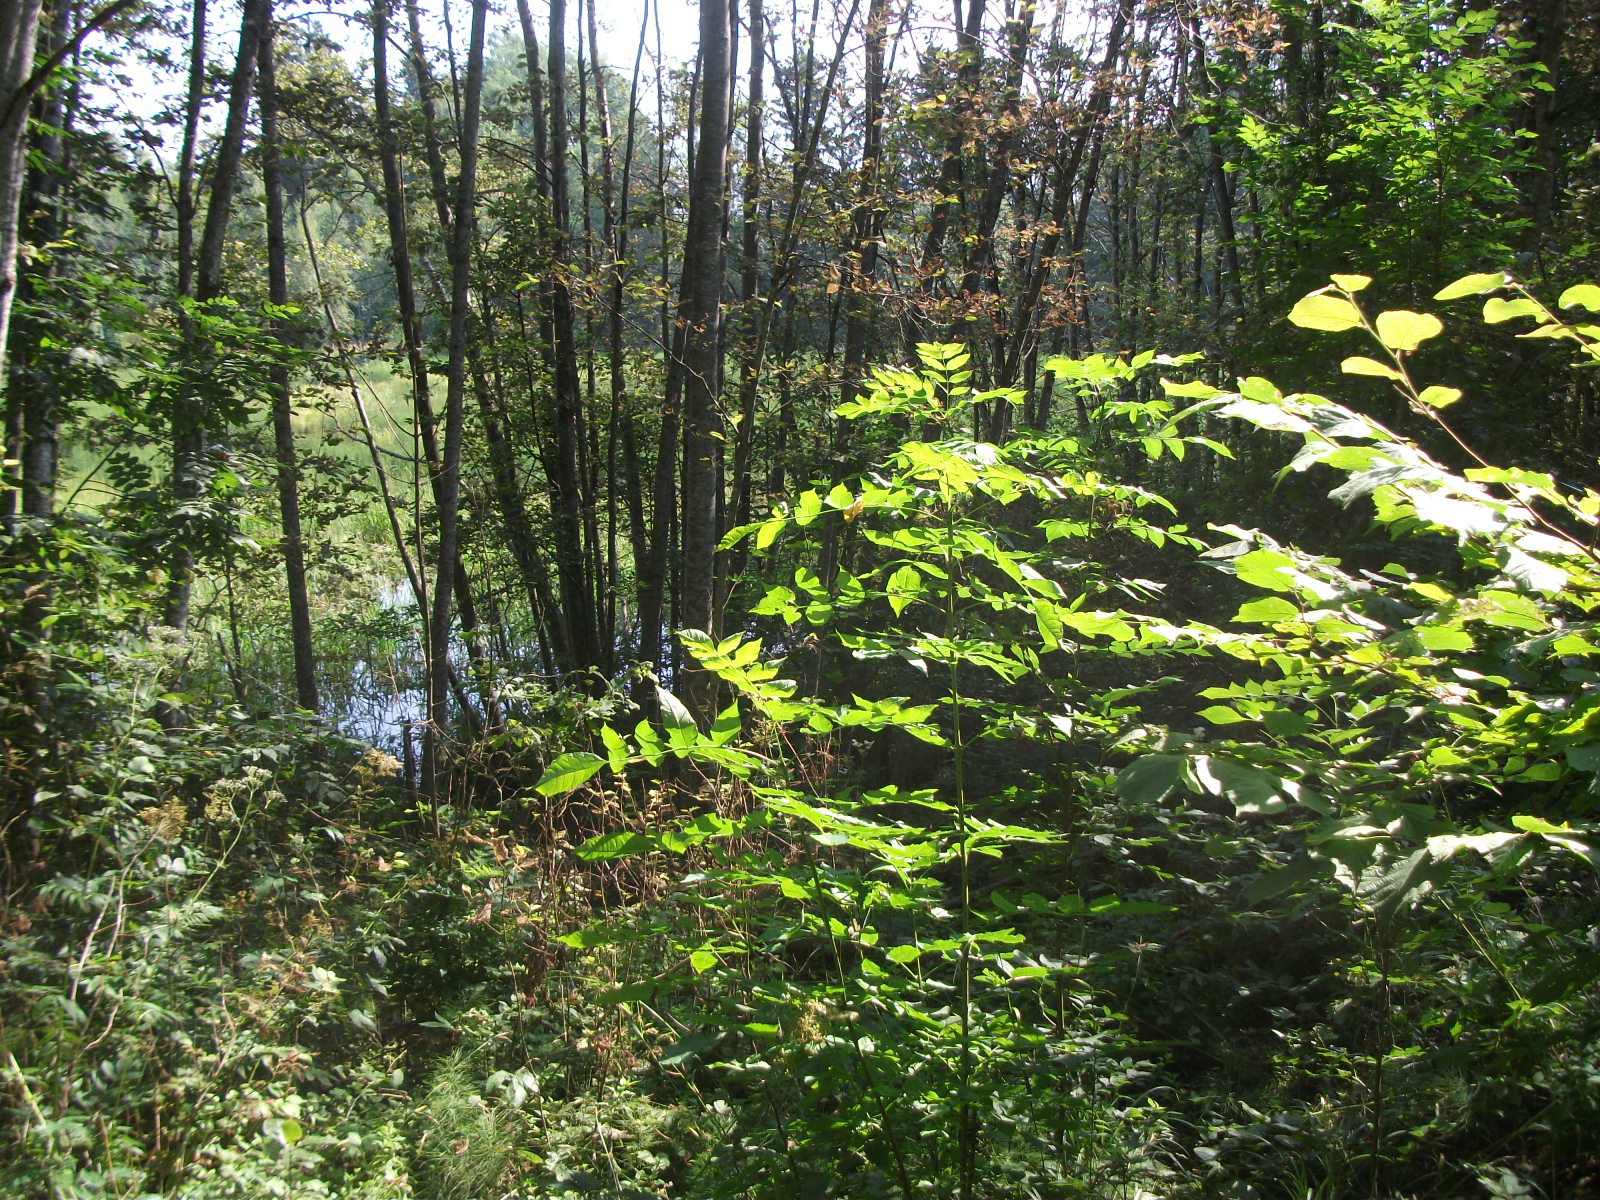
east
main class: Woodland
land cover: Broadleaved woodland
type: non-riverine alder, birch or aspen forest
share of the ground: 50 - 75 %
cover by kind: broadleaved forest trees 70 %, shrubs 10 %, herbaceous plants 10 %, unconsolidated bare surface 5 %
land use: Forestry
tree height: > 5 m
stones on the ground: < 10 %
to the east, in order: Broadleaved woodland; Inland marshes; Inland fresh water bodies; Inland marshes; Broadleaved woodland; Grassland with sparse tree/shrub cover; Broadleaved woodland; Grassland with sparse tree/shrub cover
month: August
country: LV
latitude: 56.8256
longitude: 25.5726
